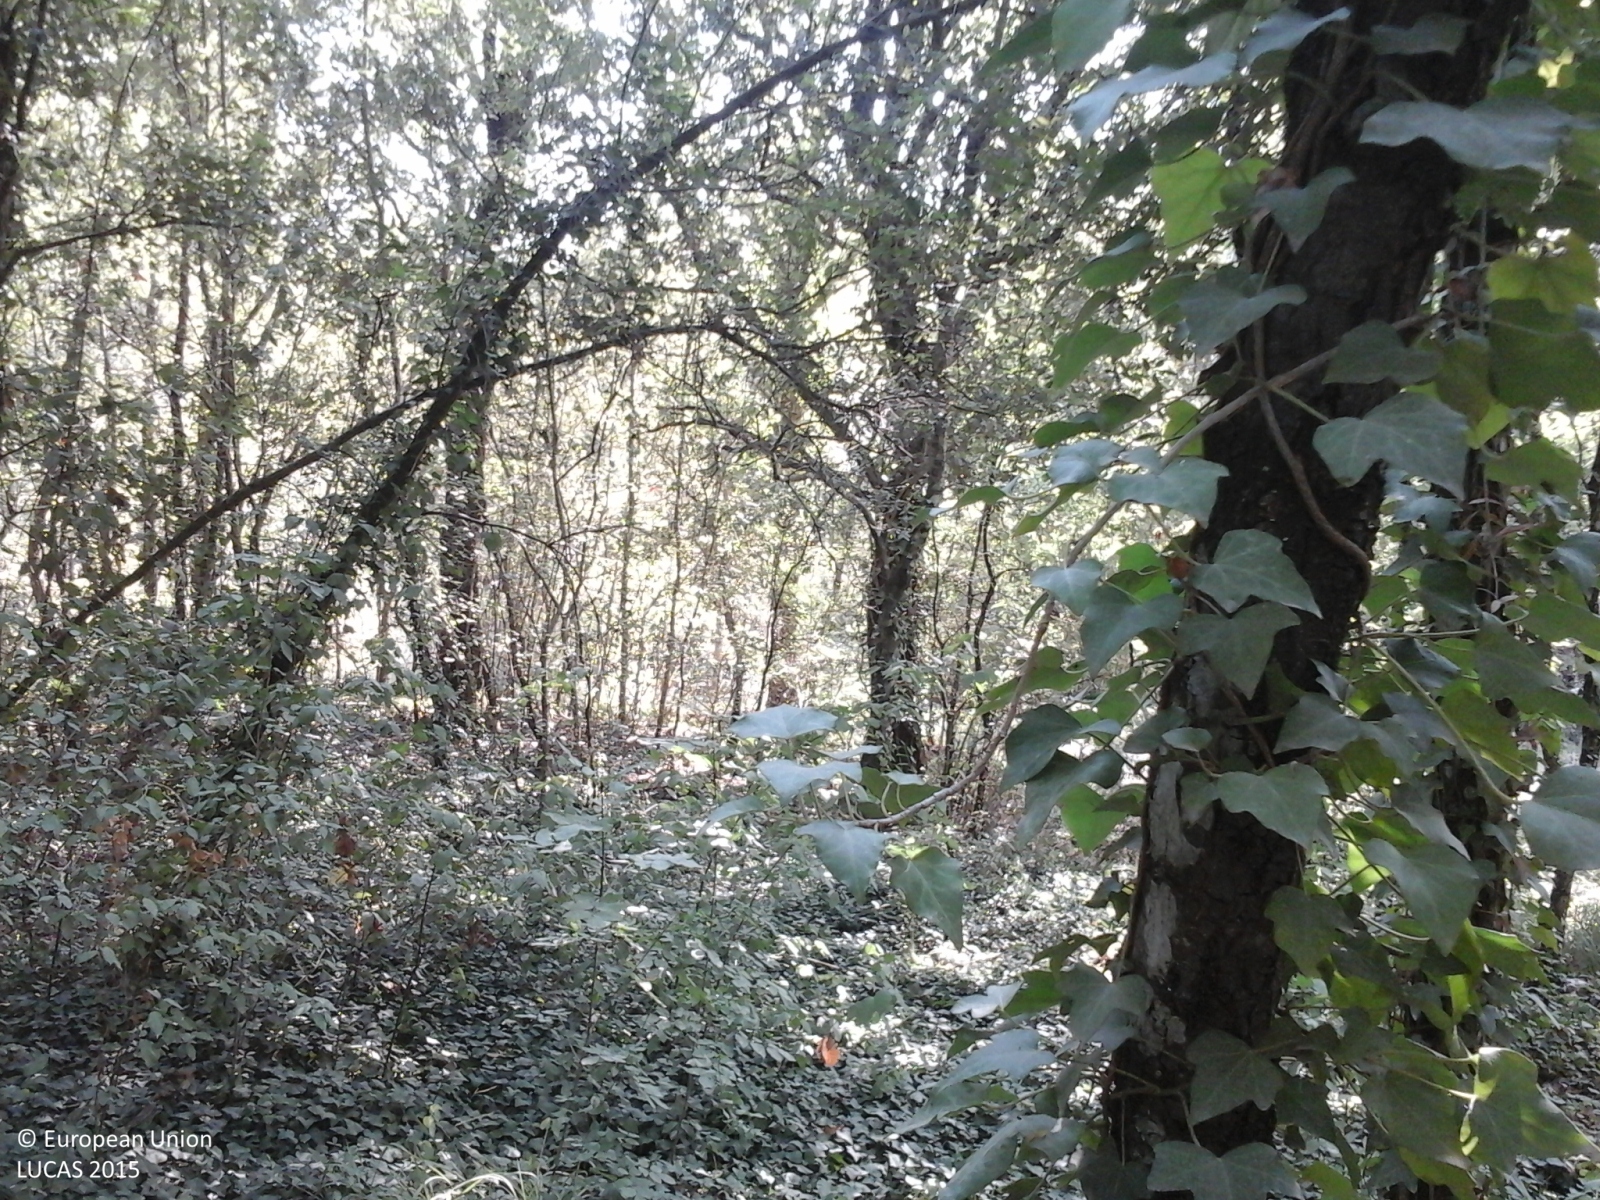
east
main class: Woodland
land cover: Broadleaved woodland
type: mesophytic deciduous forest
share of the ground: > 75 %
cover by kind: broadleaved forest trees 100 %
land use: Forestry
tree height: > 5 m
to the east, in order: Broadleaved woodland; Ditches and canals; Tracks; Ditches and canals; Broadleaved woodland; Tracks; Ditches and canals; Grassland without tree/shrub cover; Tracks
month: July
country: IT
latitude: 43.2984
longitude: 11.0693
